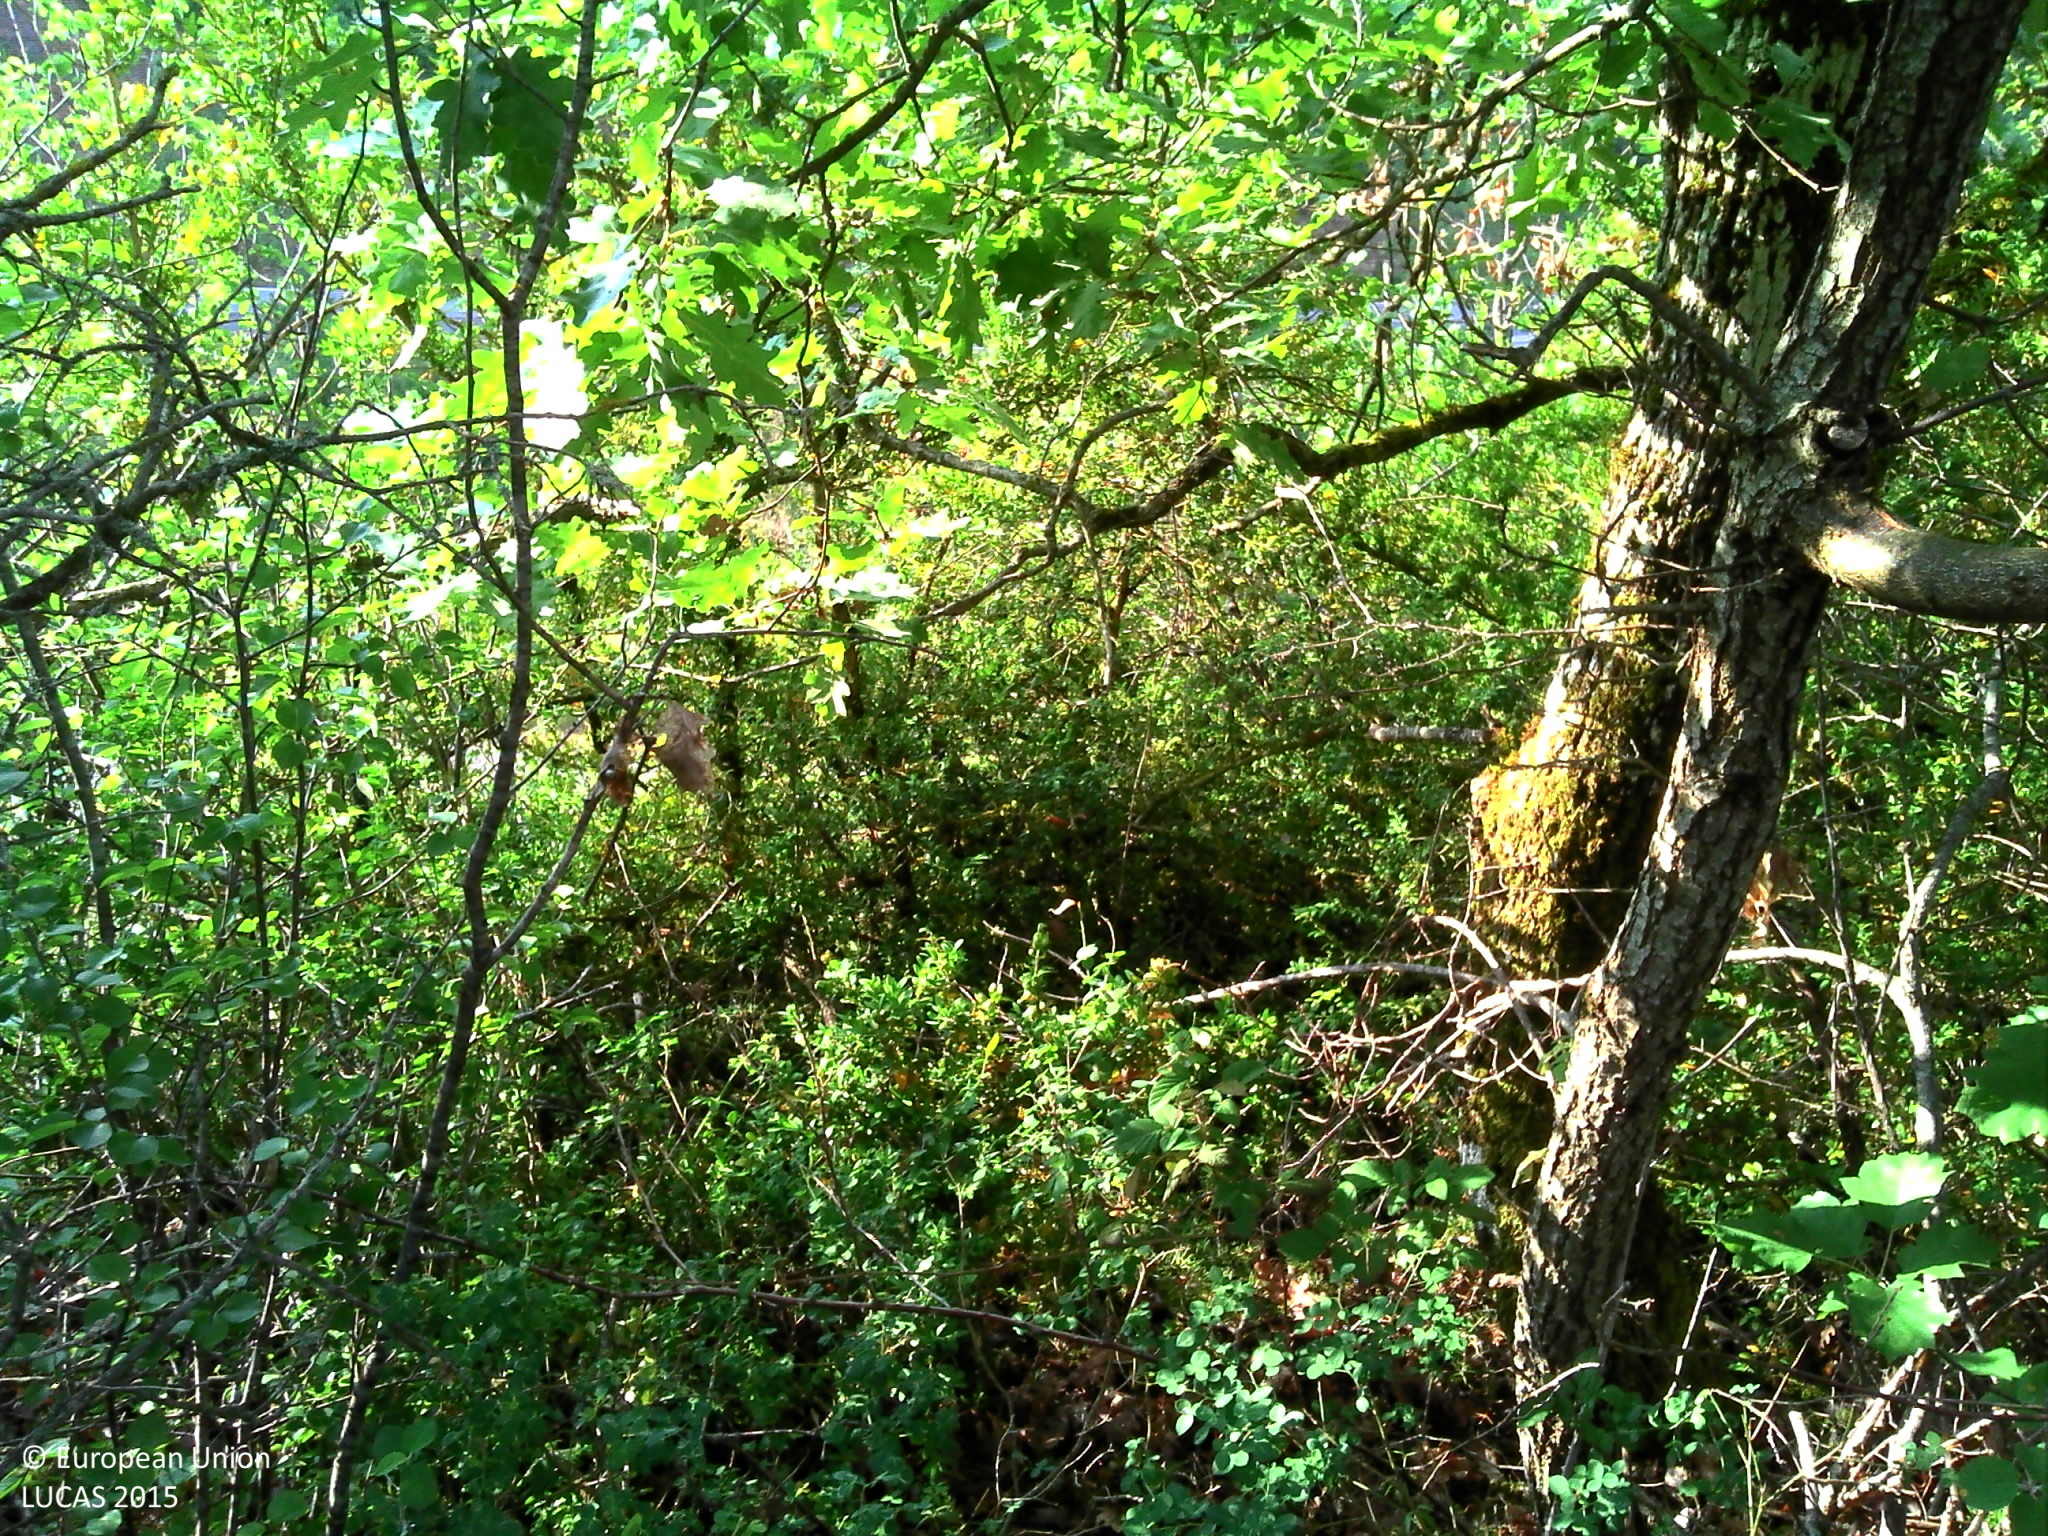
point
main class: Shrubland
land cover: Shrubland with sparse tree cover
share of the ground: > 75 %
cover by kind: shrubs 90 %, broadleaved forest trees 5 %, herbaceous plants 5 %
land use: Semi-natural and natural areas not in use
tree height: < 5 m
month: June
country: FR
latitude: 44.2102
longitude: 3.0846
